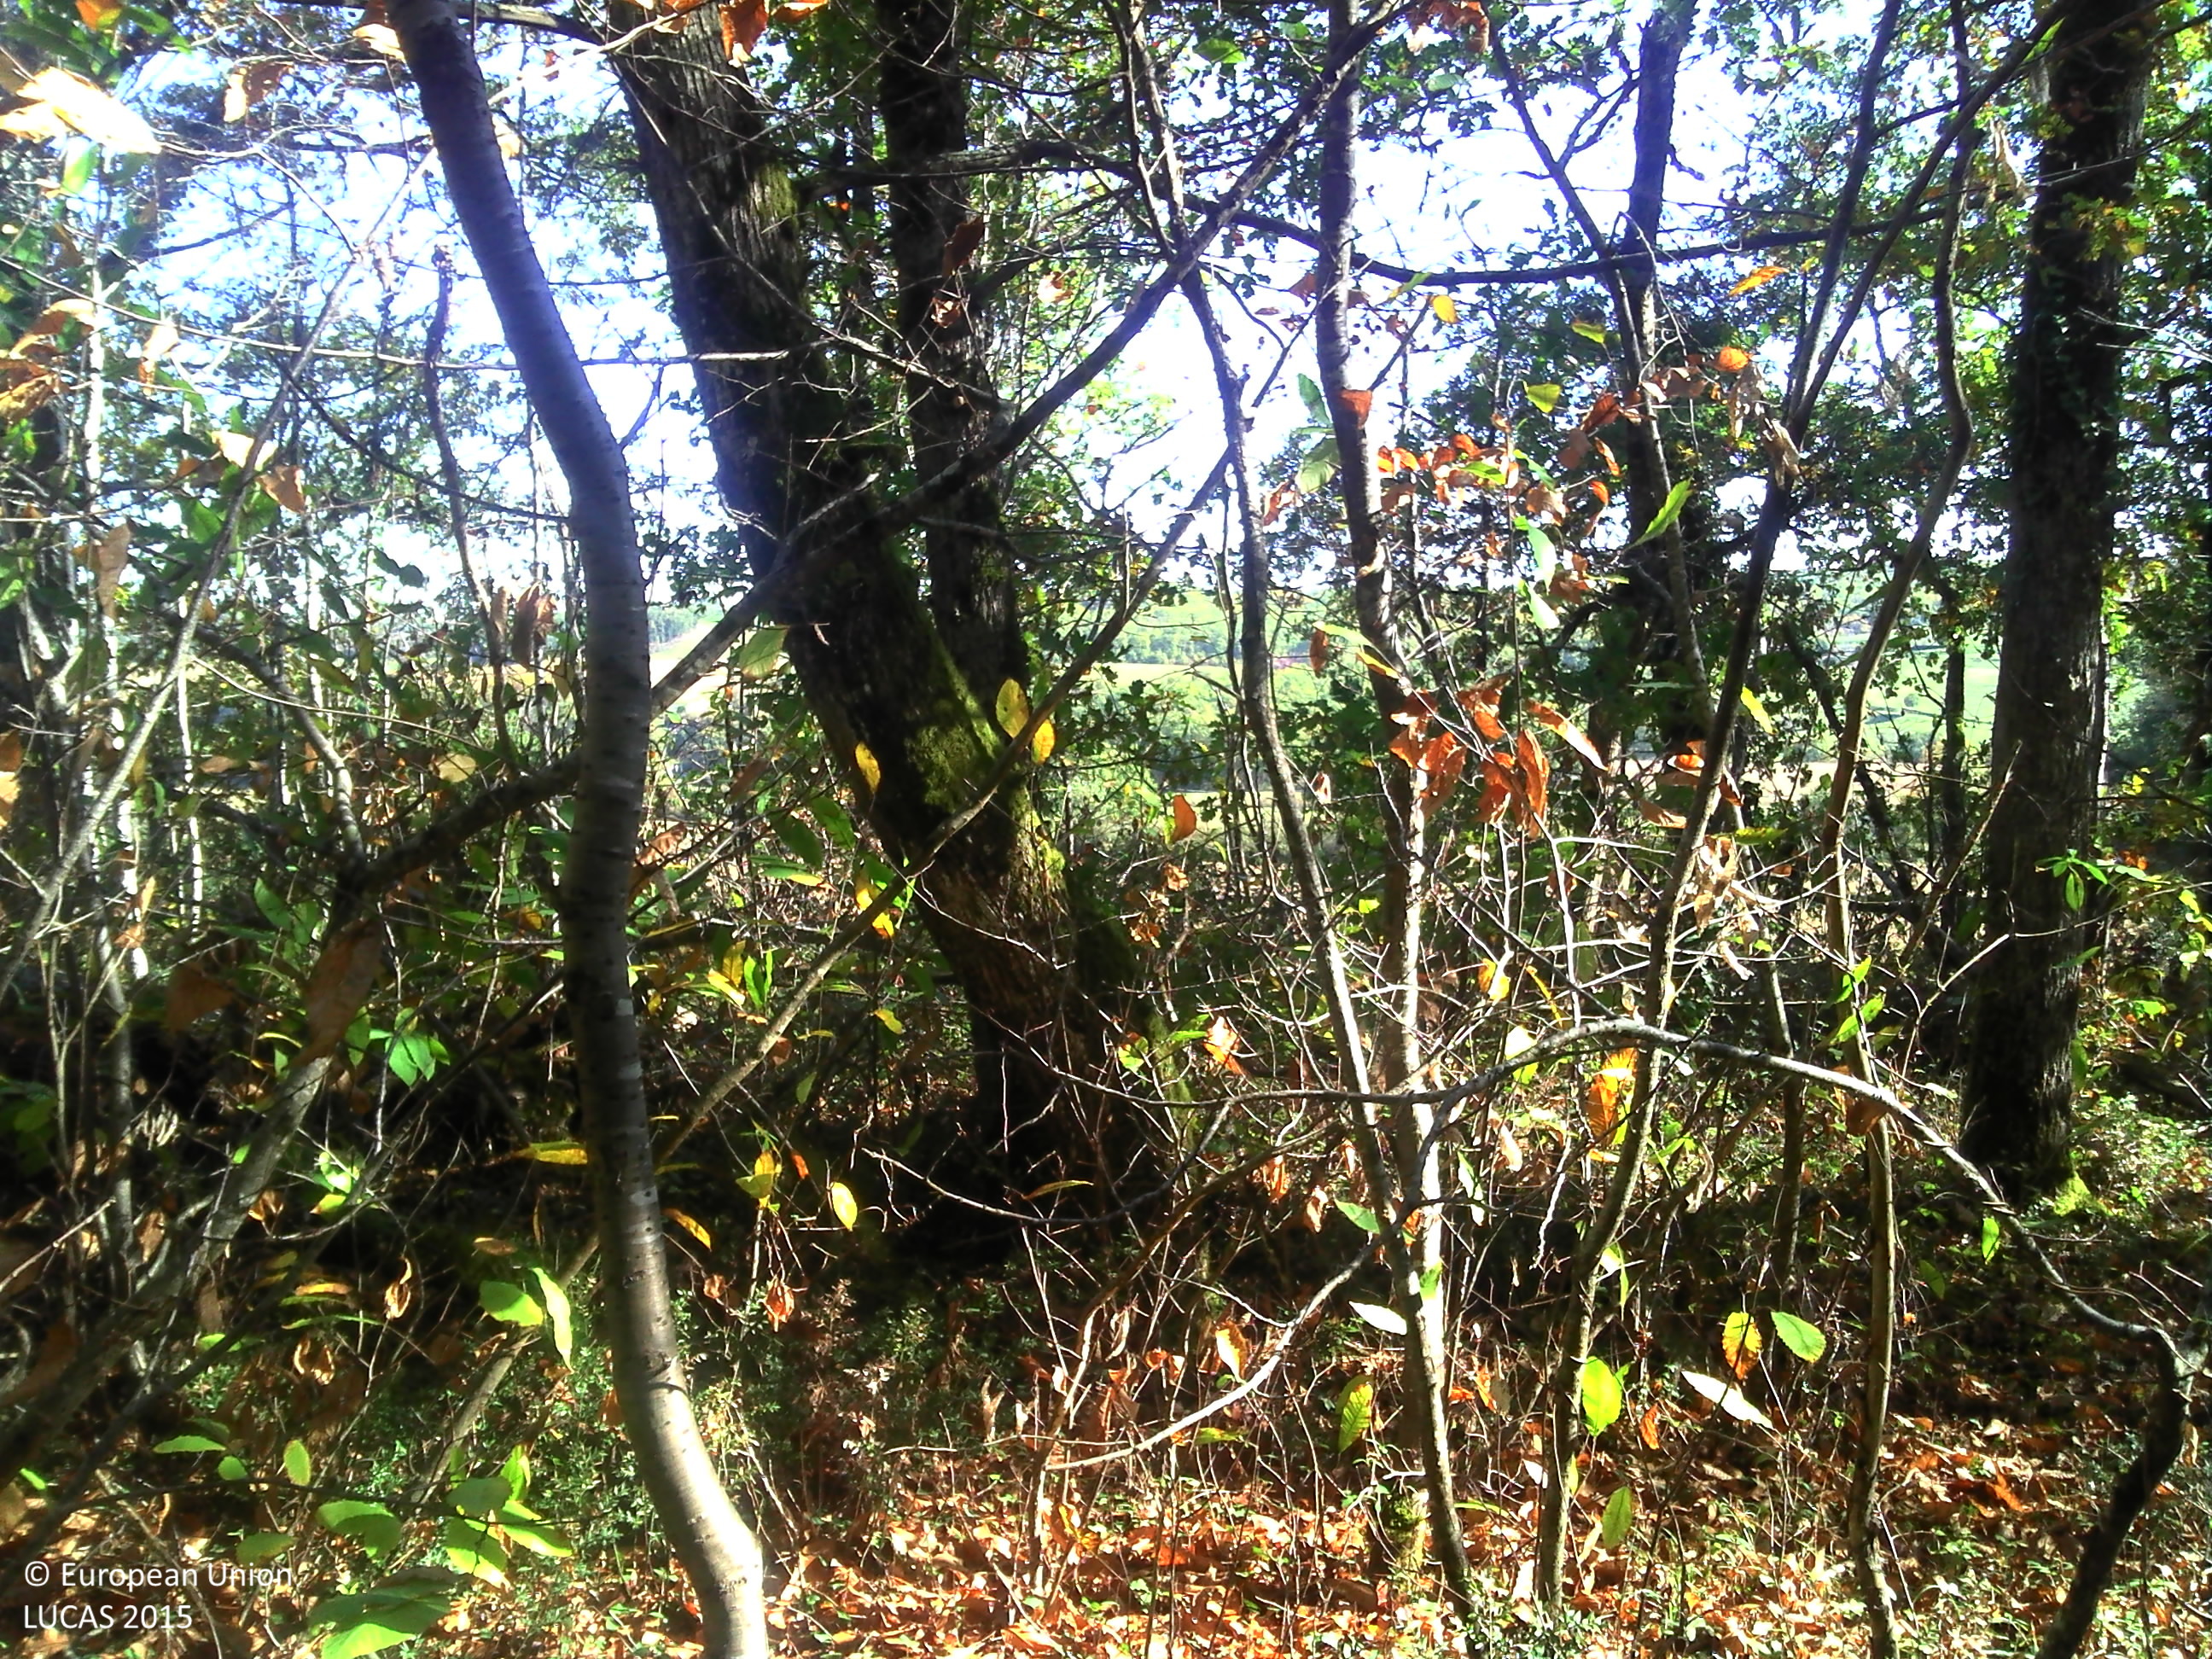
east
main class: Woodland
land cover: Broadleaved woodland
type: mesophytic deciduous forest
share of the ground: > 75 %
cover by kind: broadleaved forest trees 75 %, shrubs 15 %, herbaceous plants 5 %
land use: Forestry
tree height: > 5 m
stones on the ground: < 10 %
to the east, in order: Broadleaved woodland; Common wheat; Abandoned hedges; Fences; Shruby margins; Grassland without tree/shrub cover; Broadleaved woodland
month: October
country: FR
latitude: 44.0206
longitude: 0.8779
